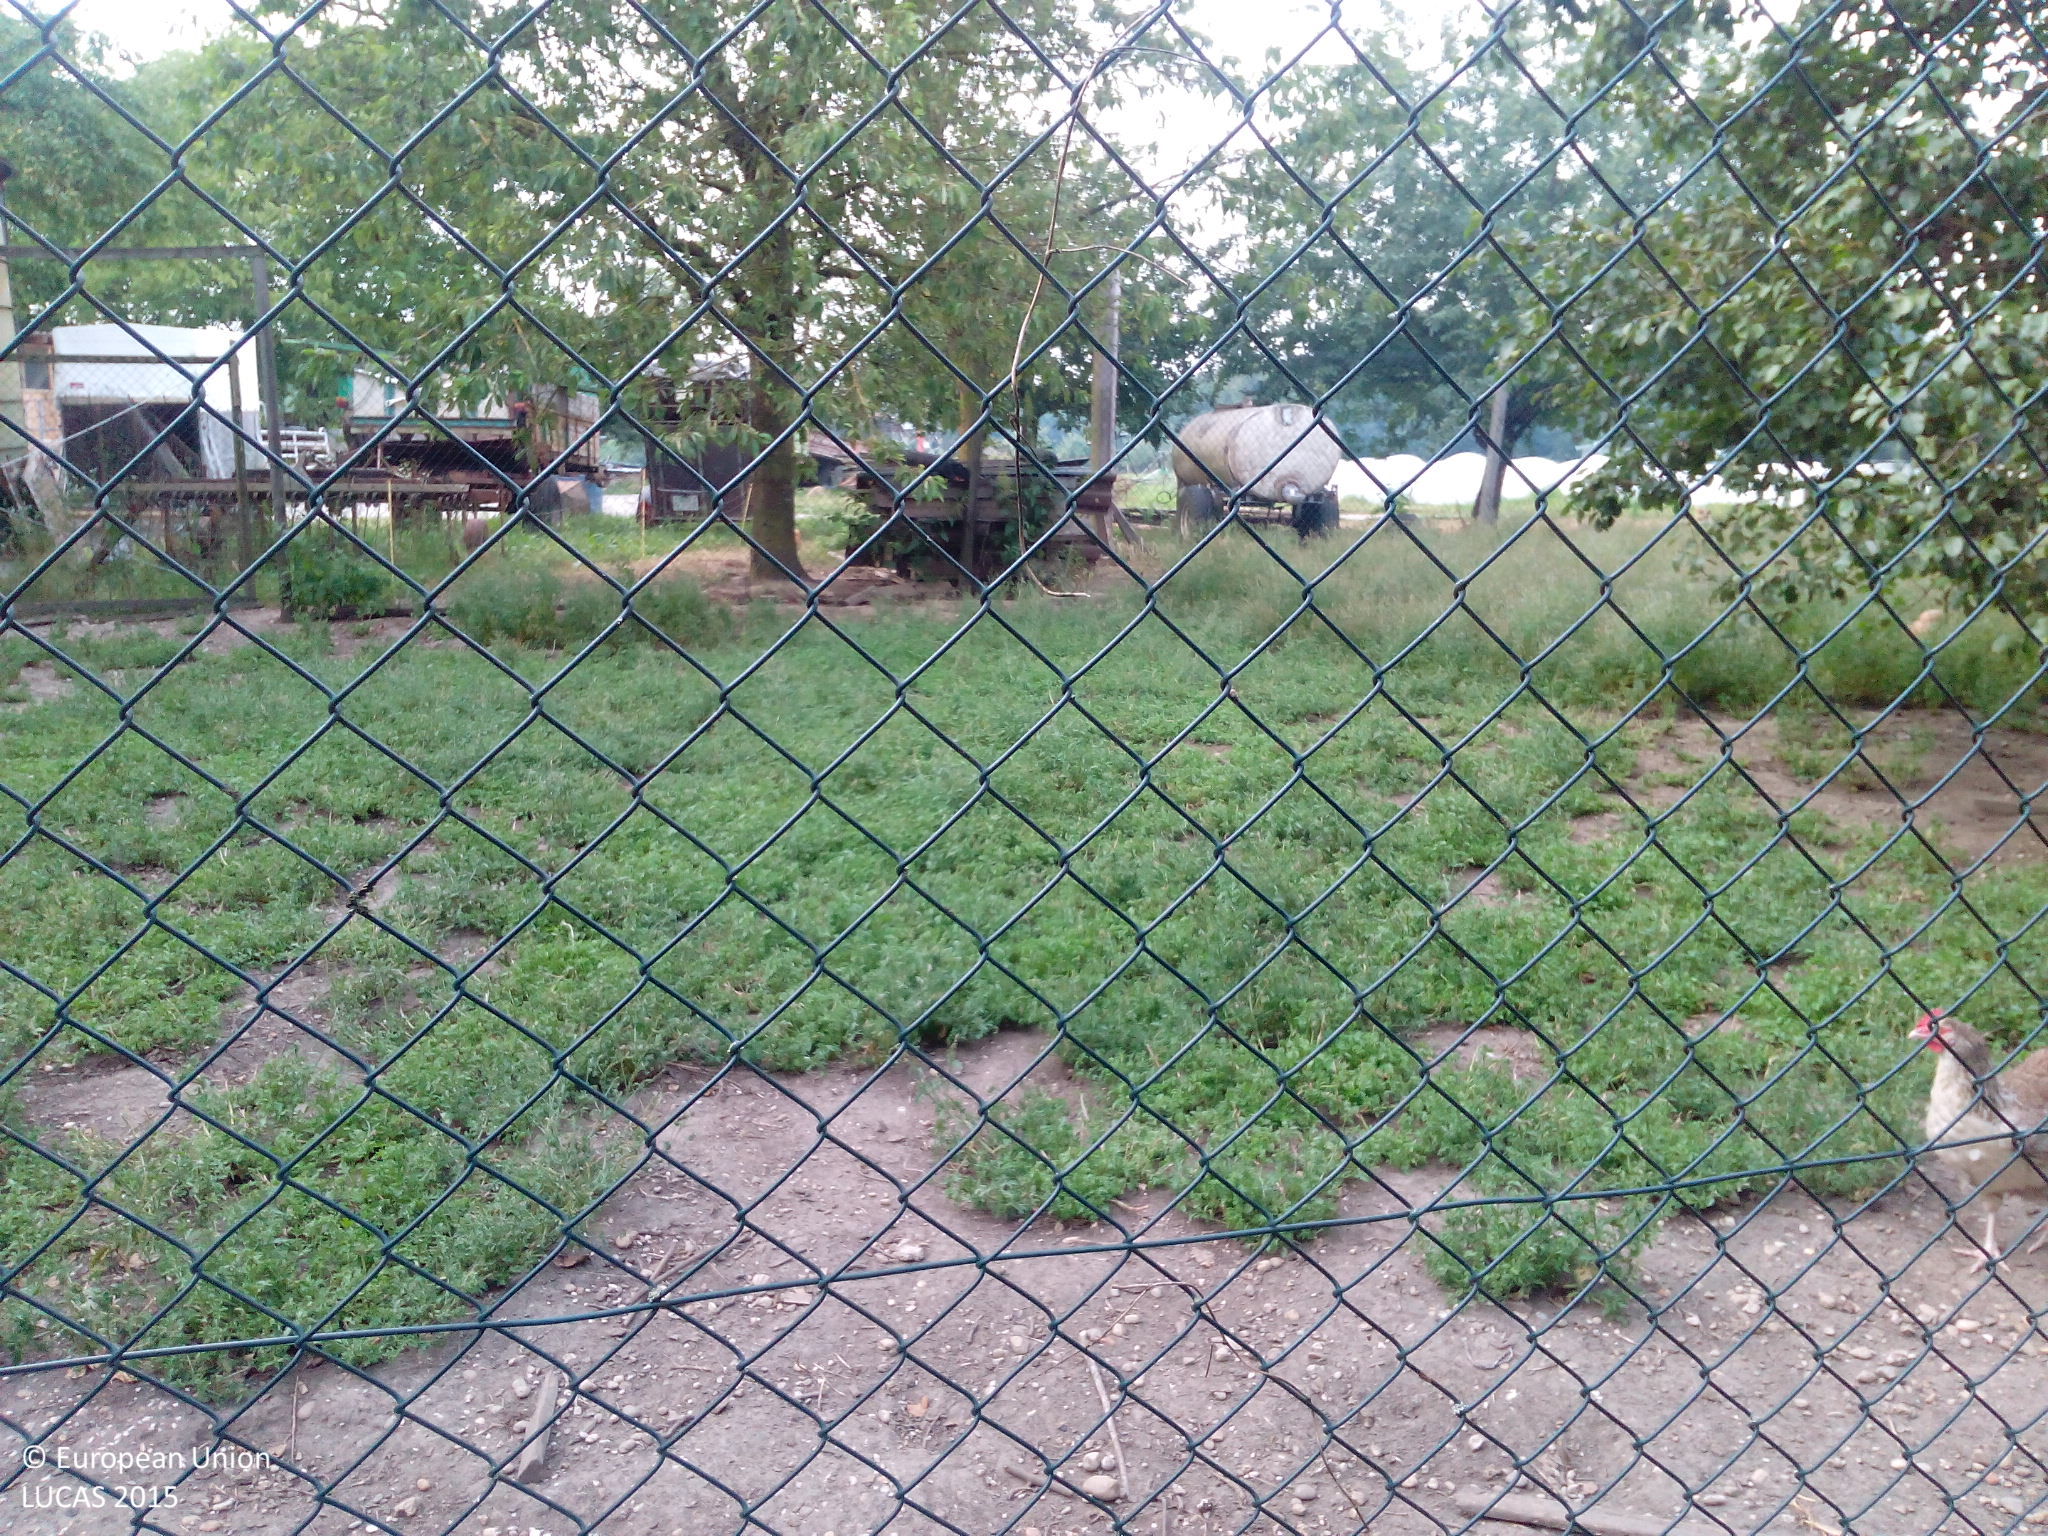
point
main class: Grassland
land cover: Spontaneously vegetated surfaces
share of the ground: 25 - 50 %
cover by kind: unconsolidated bare surface 60 %, herbaceous plants 40 %
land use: Agriculture (excluding fallow land and kitchen gardens)
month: July
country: DE
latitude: 48.1878
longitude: 12.8103
